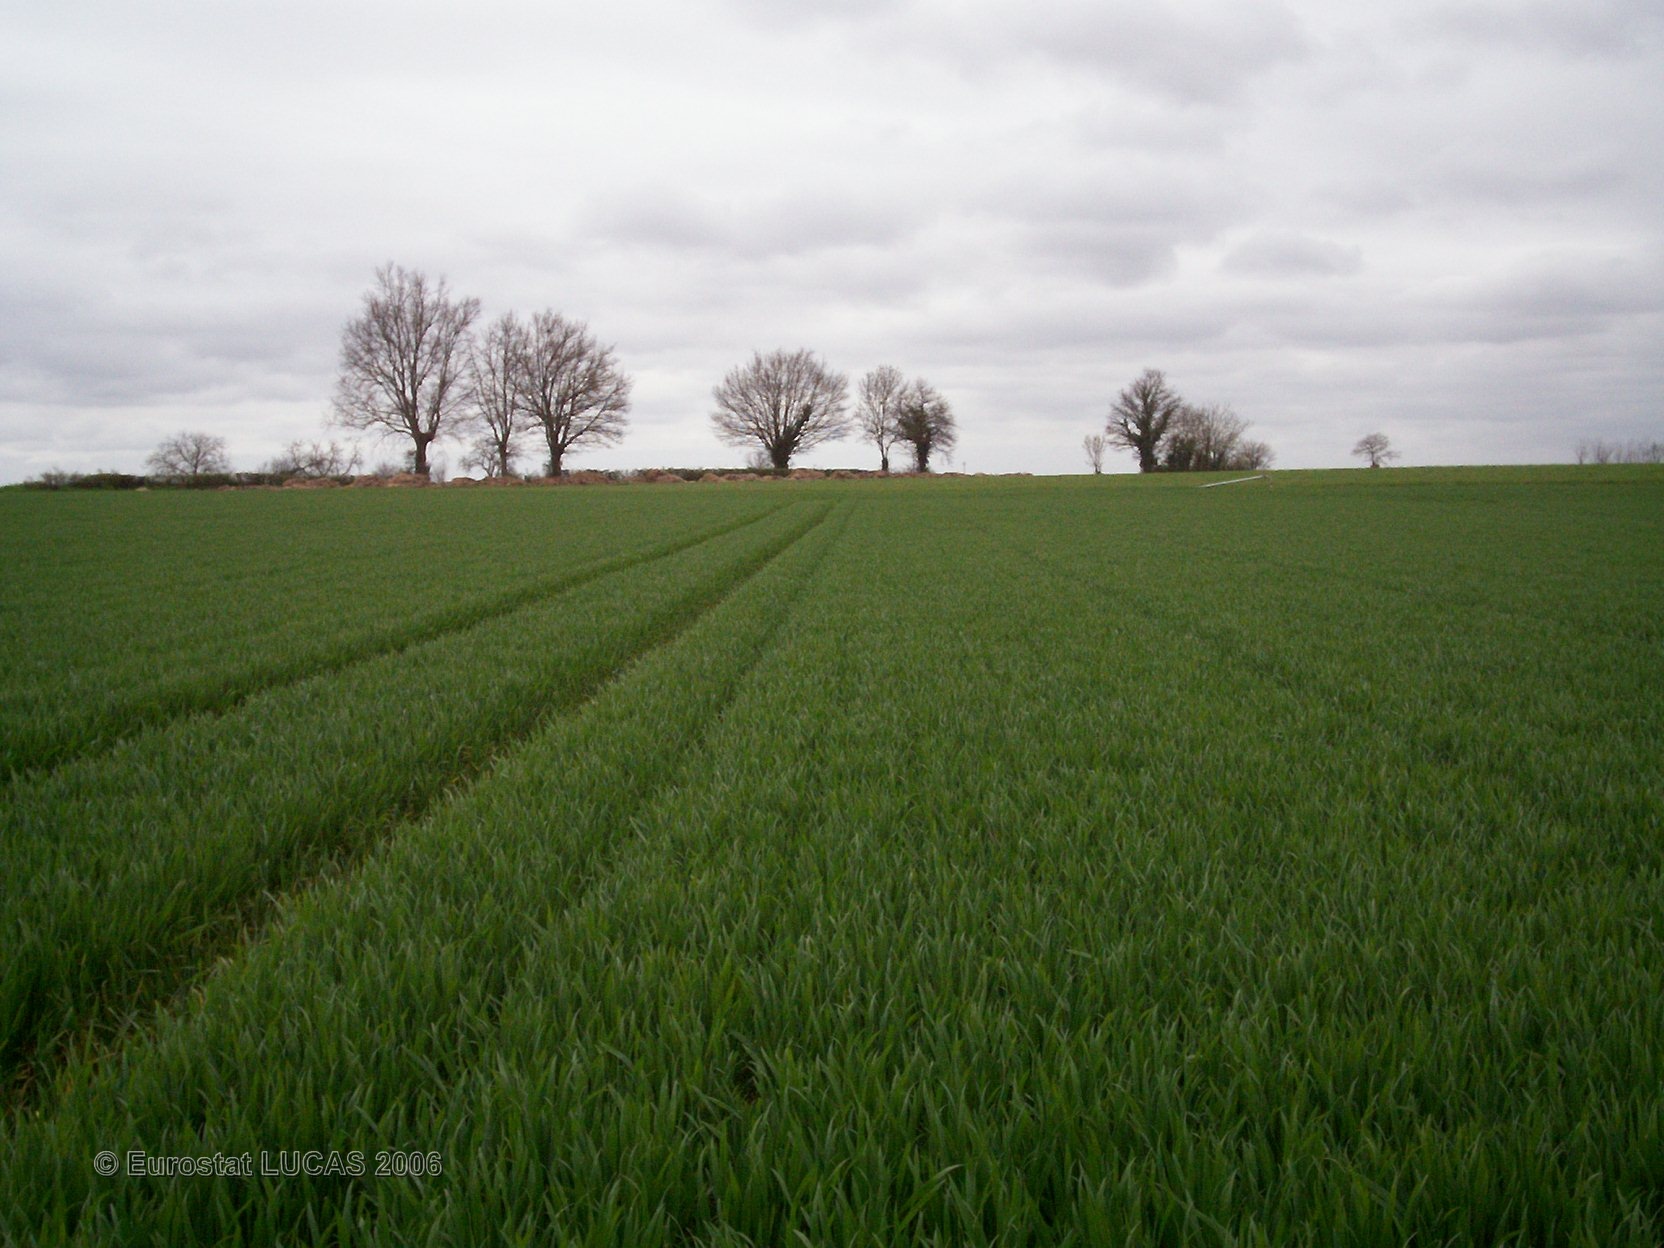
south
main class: Cropland
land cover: Common wheat
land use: Agriculture (excluding fallow land and kitchen gardens)
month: April
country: FR
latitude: 46.2788
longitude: -0.2102
